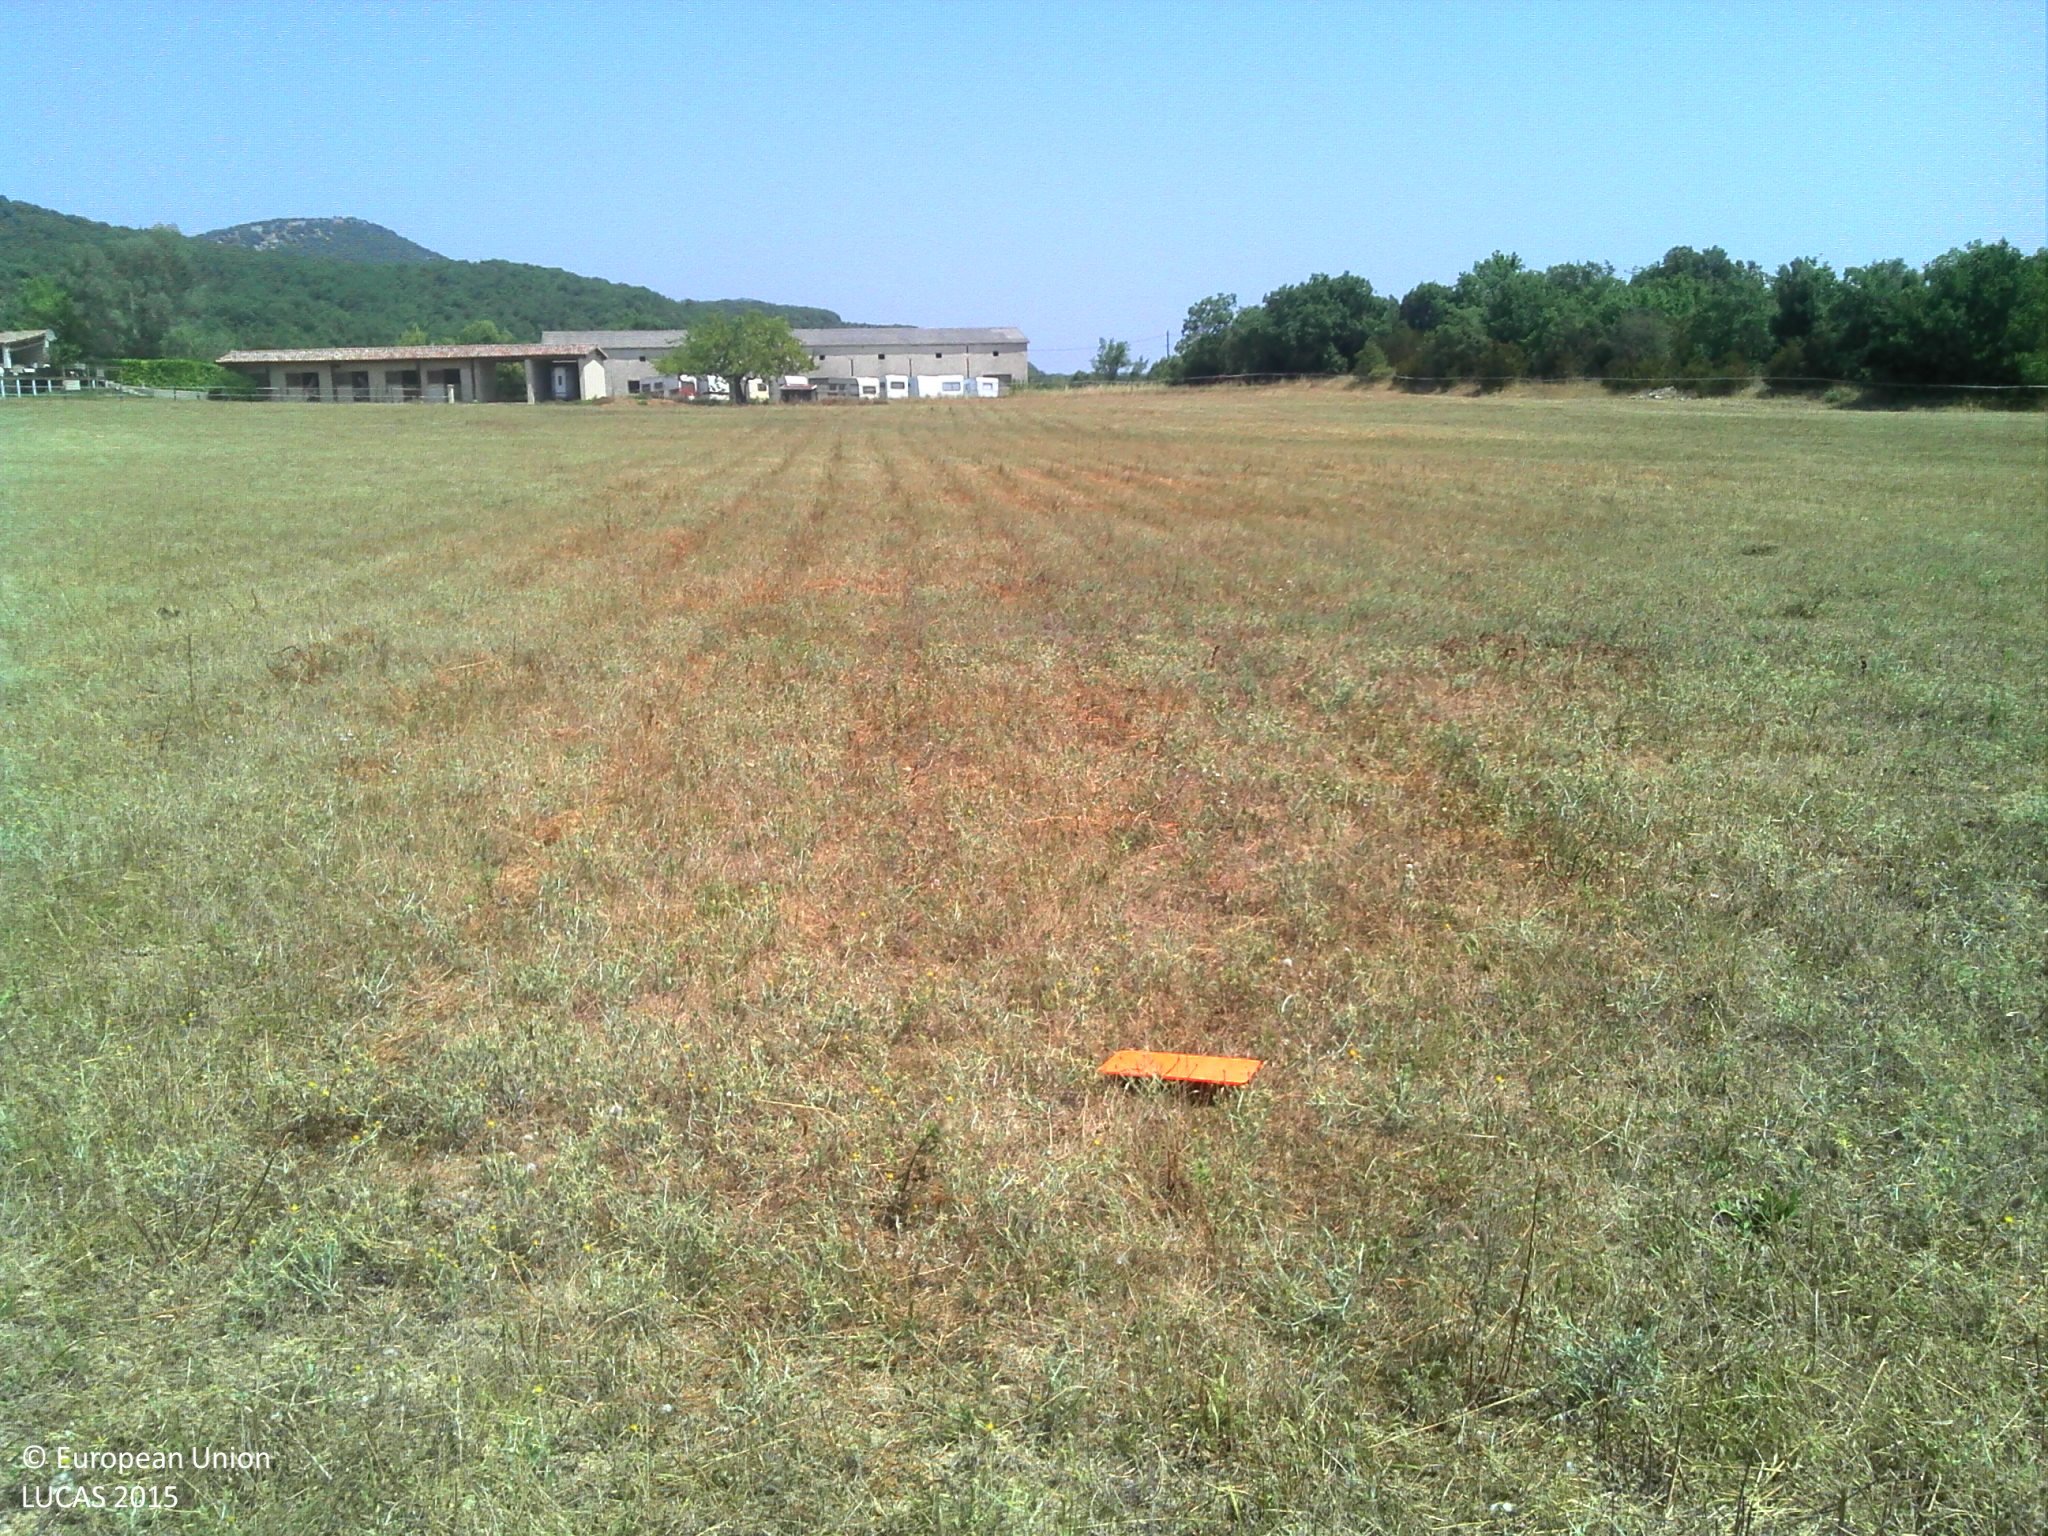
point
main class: Grassland
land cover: Grassland without tree/shrub cover
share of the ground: > 75 %
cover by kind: herbaceous plants 100 %
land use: Sport
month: July
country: FR
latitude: 44.3371
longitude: 4.2753
